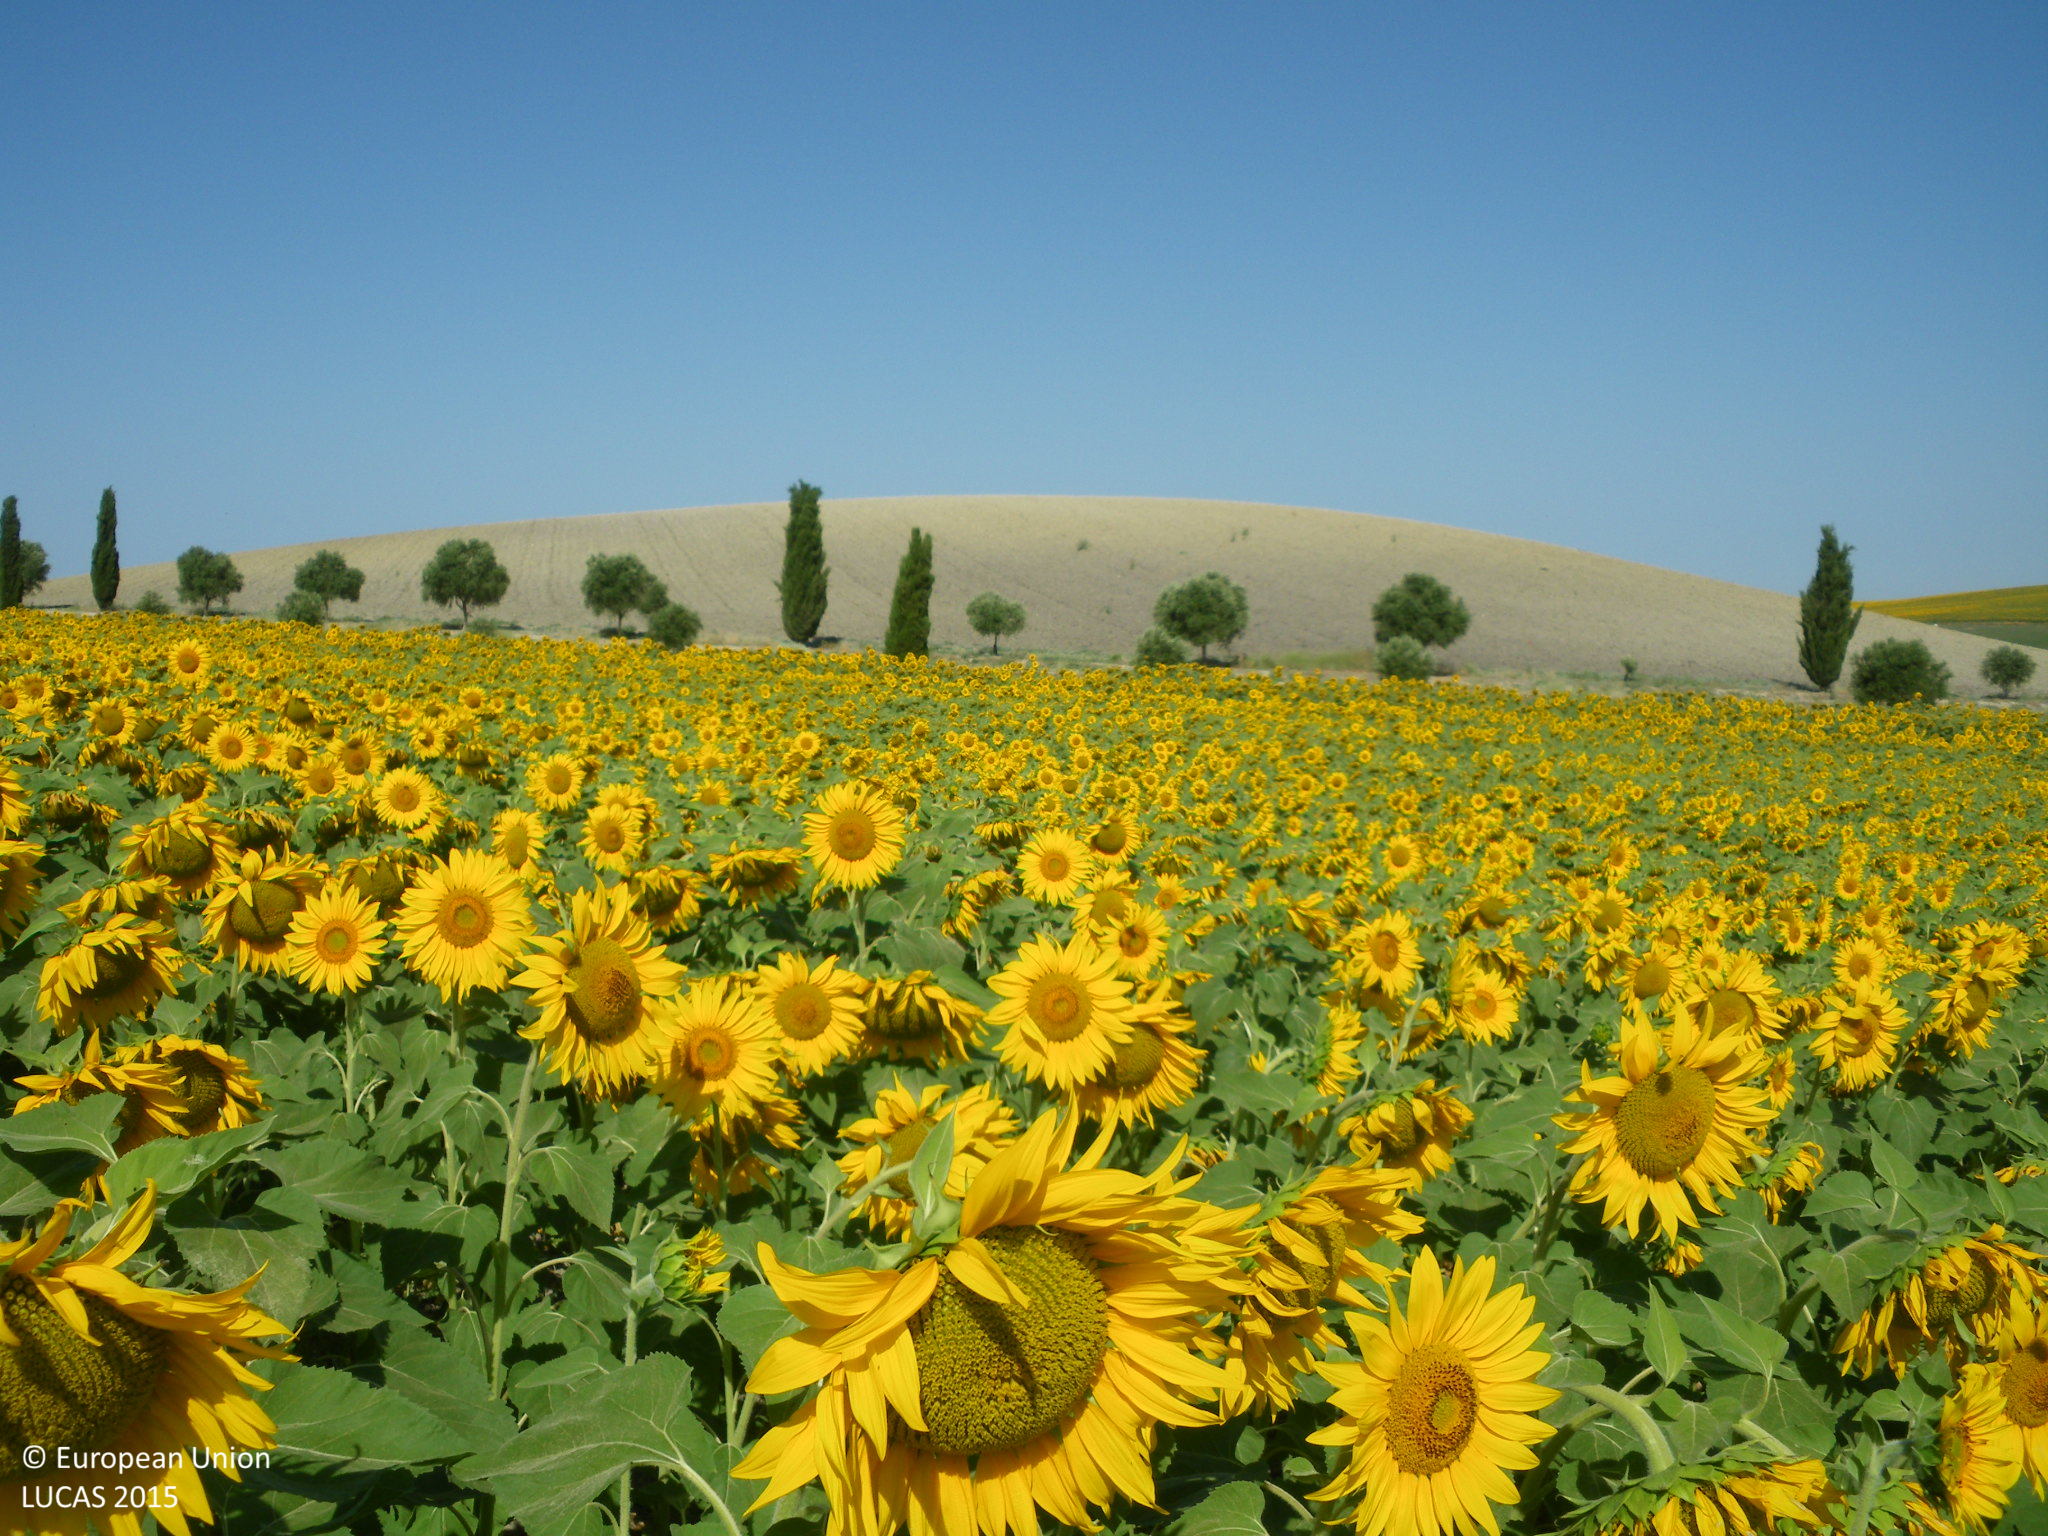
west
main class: Cropland
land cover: Sunflower
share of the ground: > 75 %
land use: Agriculture (excluding fallow land and kitchen gardens)
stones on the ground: < 10 %
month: June
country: ES
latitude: 36.7745
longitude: -5.9772
